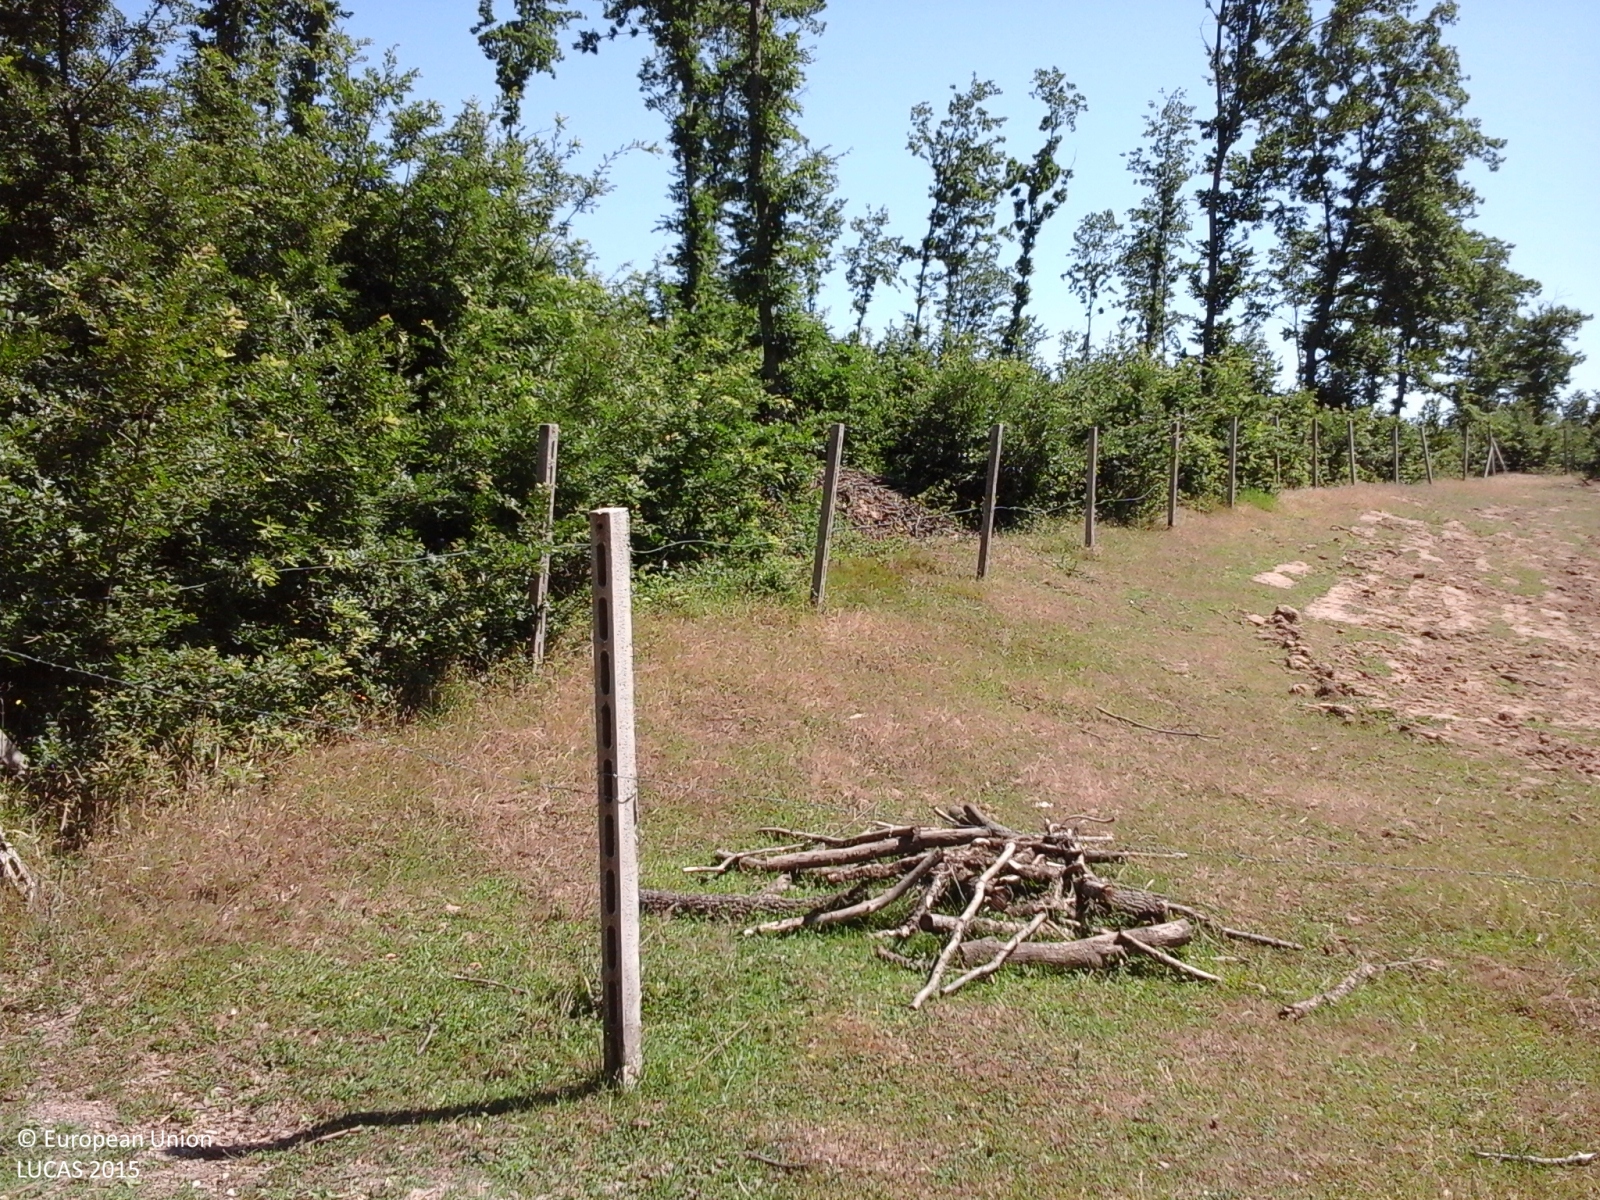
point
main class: Woodland
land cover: Broadleaved woodland
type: thermophilous deciduous forest
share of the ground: > 75 %
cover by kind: broadleaved forest trees 100 %
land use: Forestry
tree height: > 5 m
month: July
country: IT
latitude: 41.6570
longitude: 14.7273
